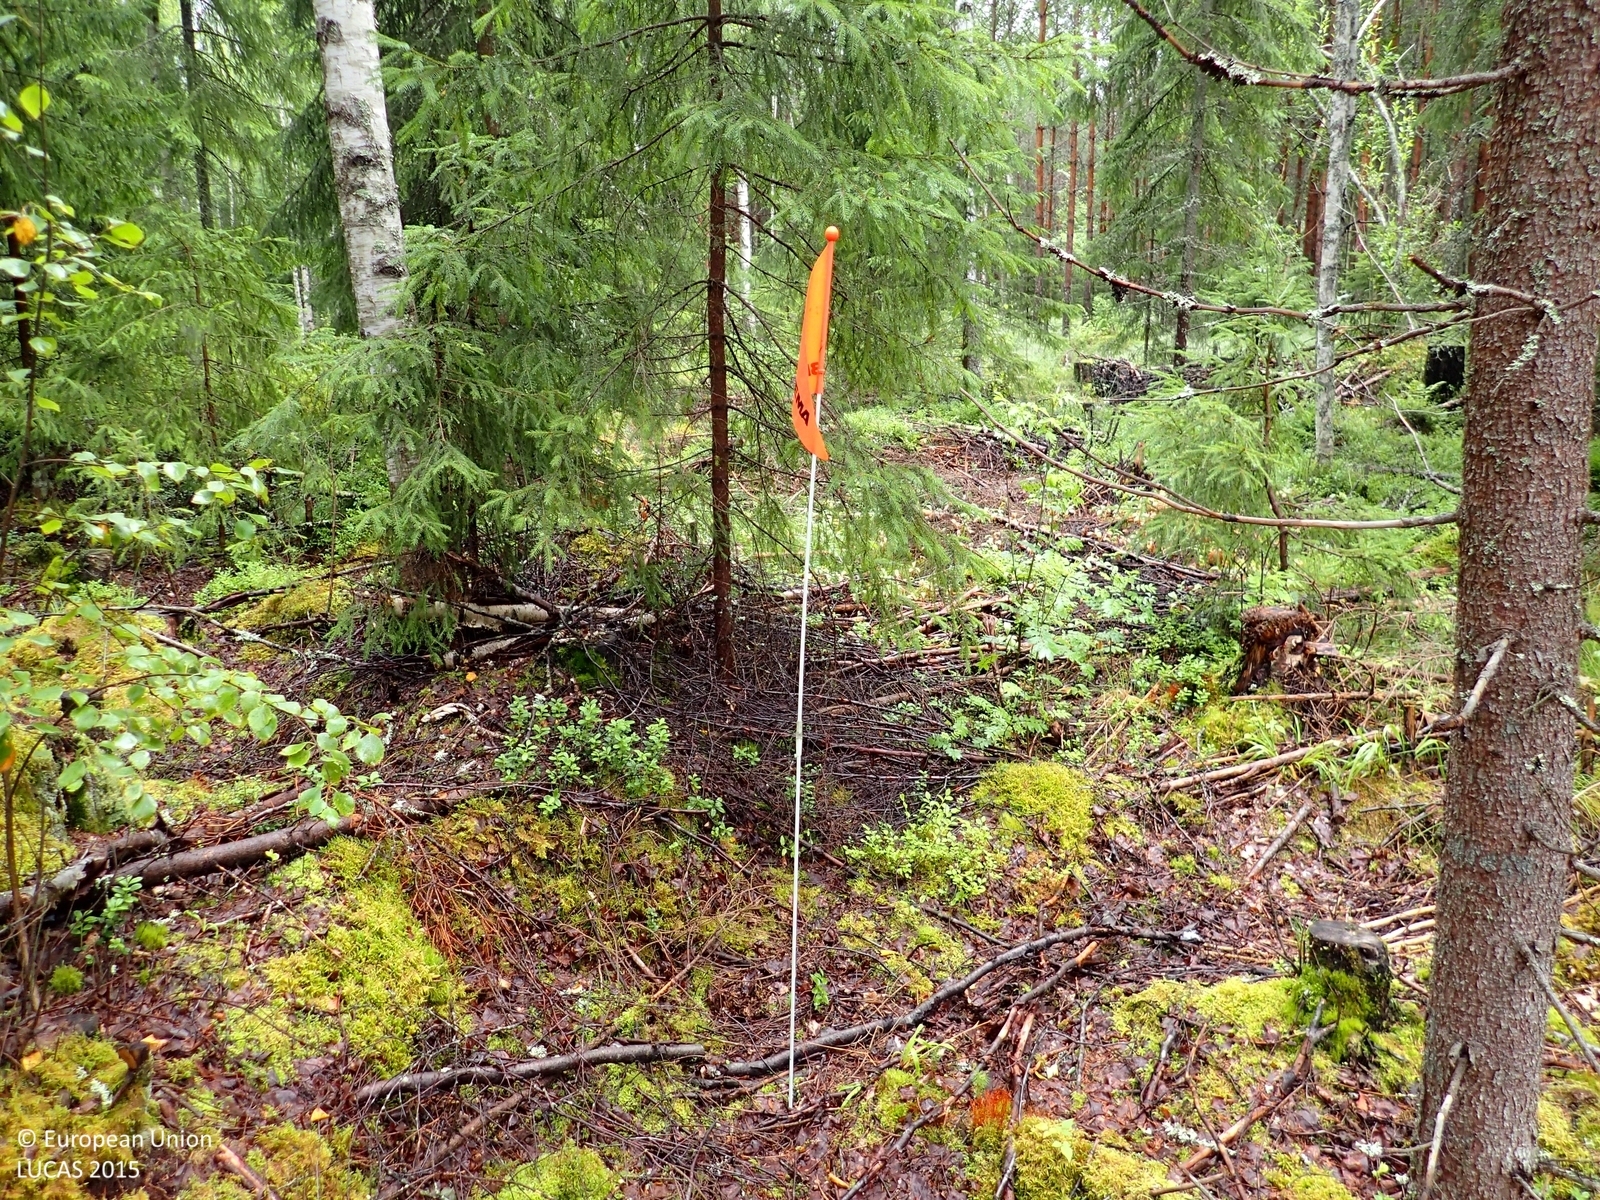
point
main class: Woodland
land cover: Spruce dominated mixed woodland
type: boreal forest
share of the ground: > 75 %
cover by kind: coniferous forest trees 55 %, broadleaved forest trees 20 %, shrubs 15 %, herbaceous plants 5 %, lichens and mosses 5 %
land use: Forestry
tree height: > 5 m
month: July
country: FI
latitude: 62.9774
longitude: 22.8205
